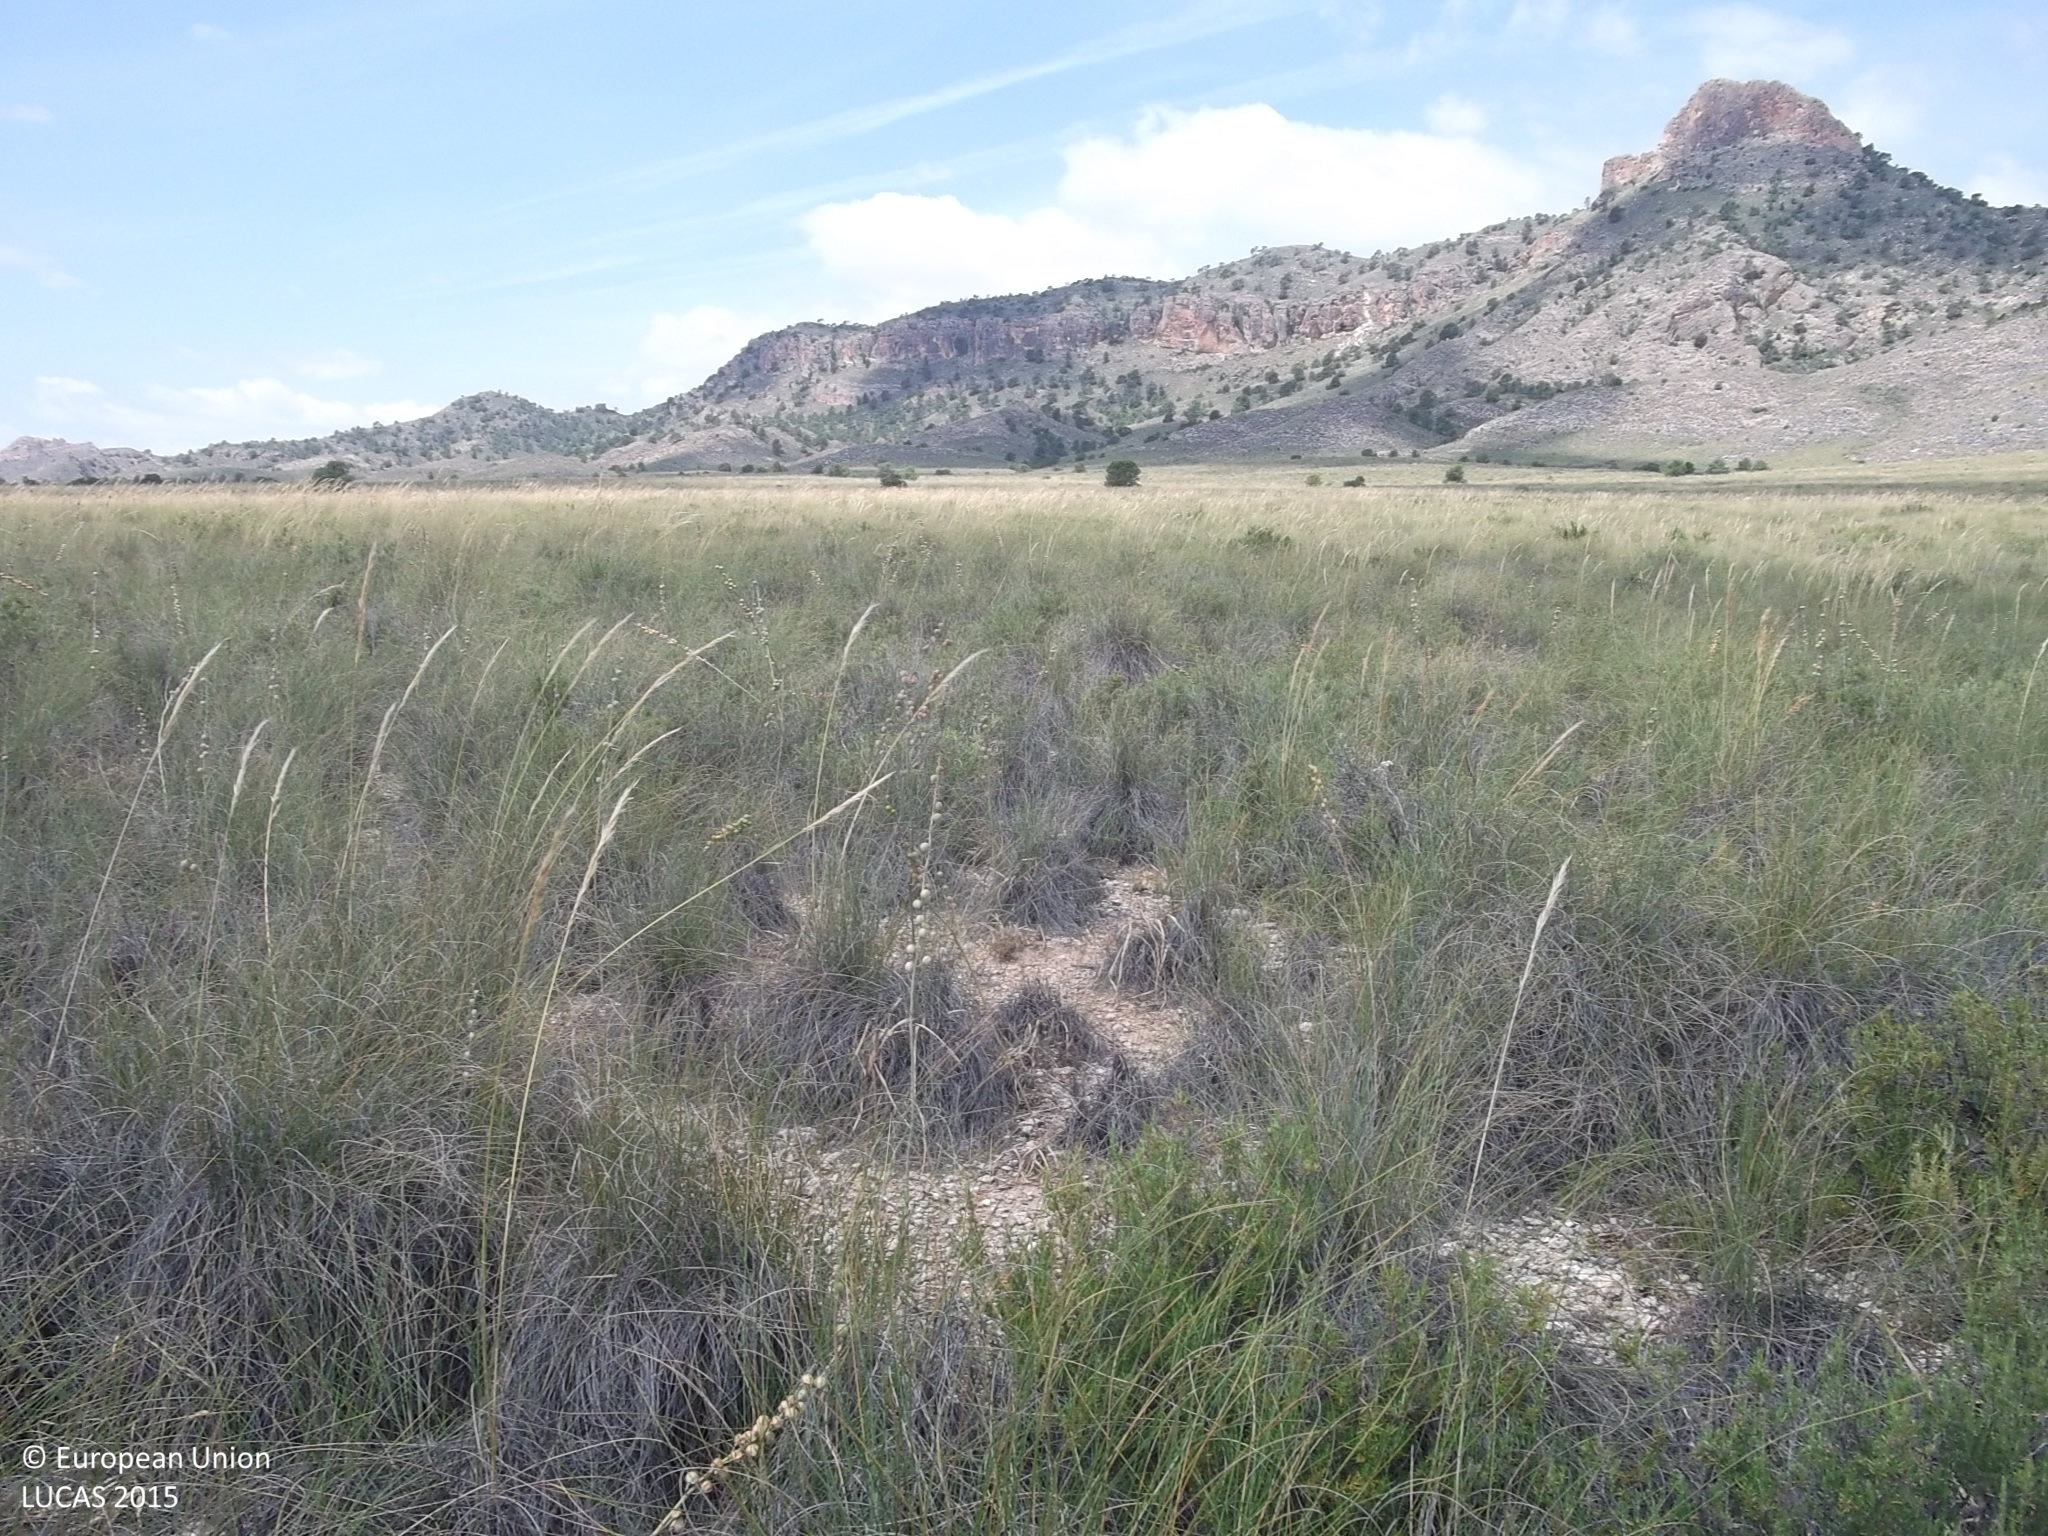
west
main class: Shrubland
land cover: Shrubland without tree cover
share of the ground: 25 - 50 %
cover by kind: shrubs 40 %, herbaceous plants 40 %, consolidated bare surface 20 %
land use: Semi-natural and natural areas not in use
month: May
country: ES
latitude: 38.3682
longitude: -1.4701
